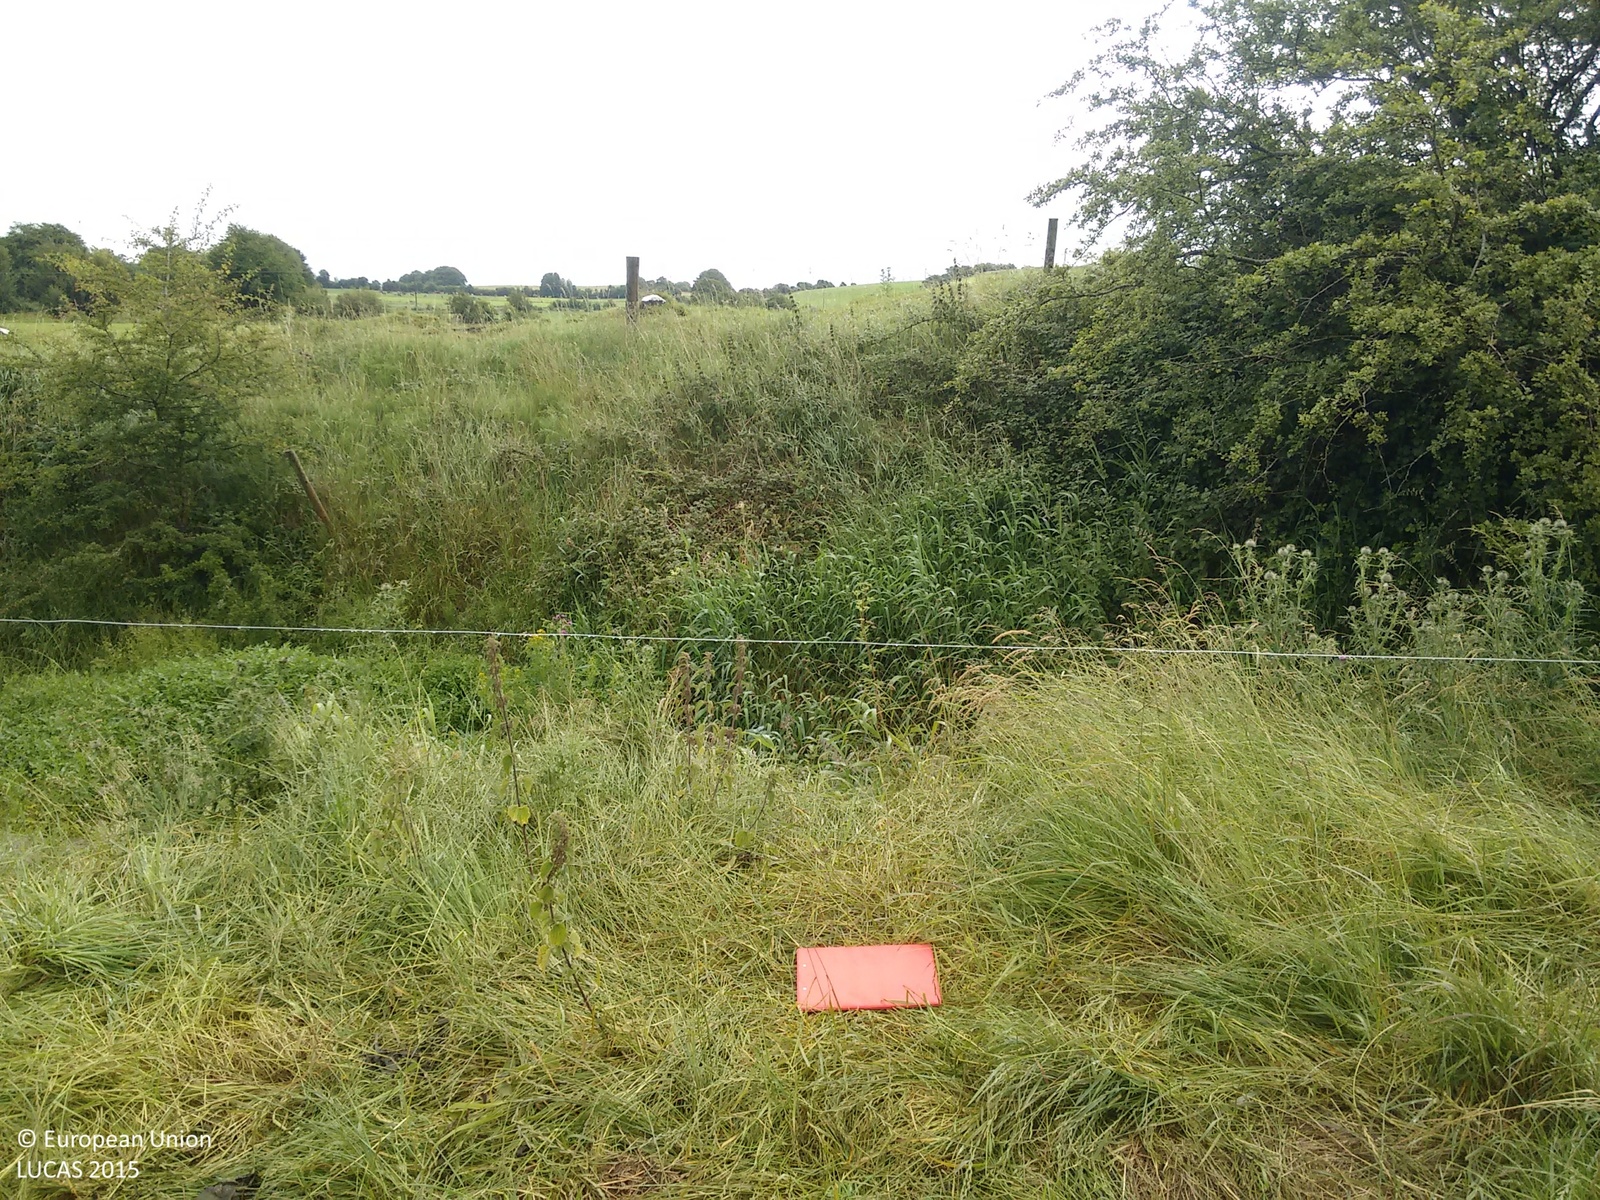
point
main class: Grassland
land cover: Grassland without tree/shrub cover
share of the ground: > 75 %
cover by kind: herbaceous plants 100 %
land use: Agriculture (excluding fallow land and kitchen gardens)
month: July
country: IE
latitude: 53.4806
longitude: -7.8452
